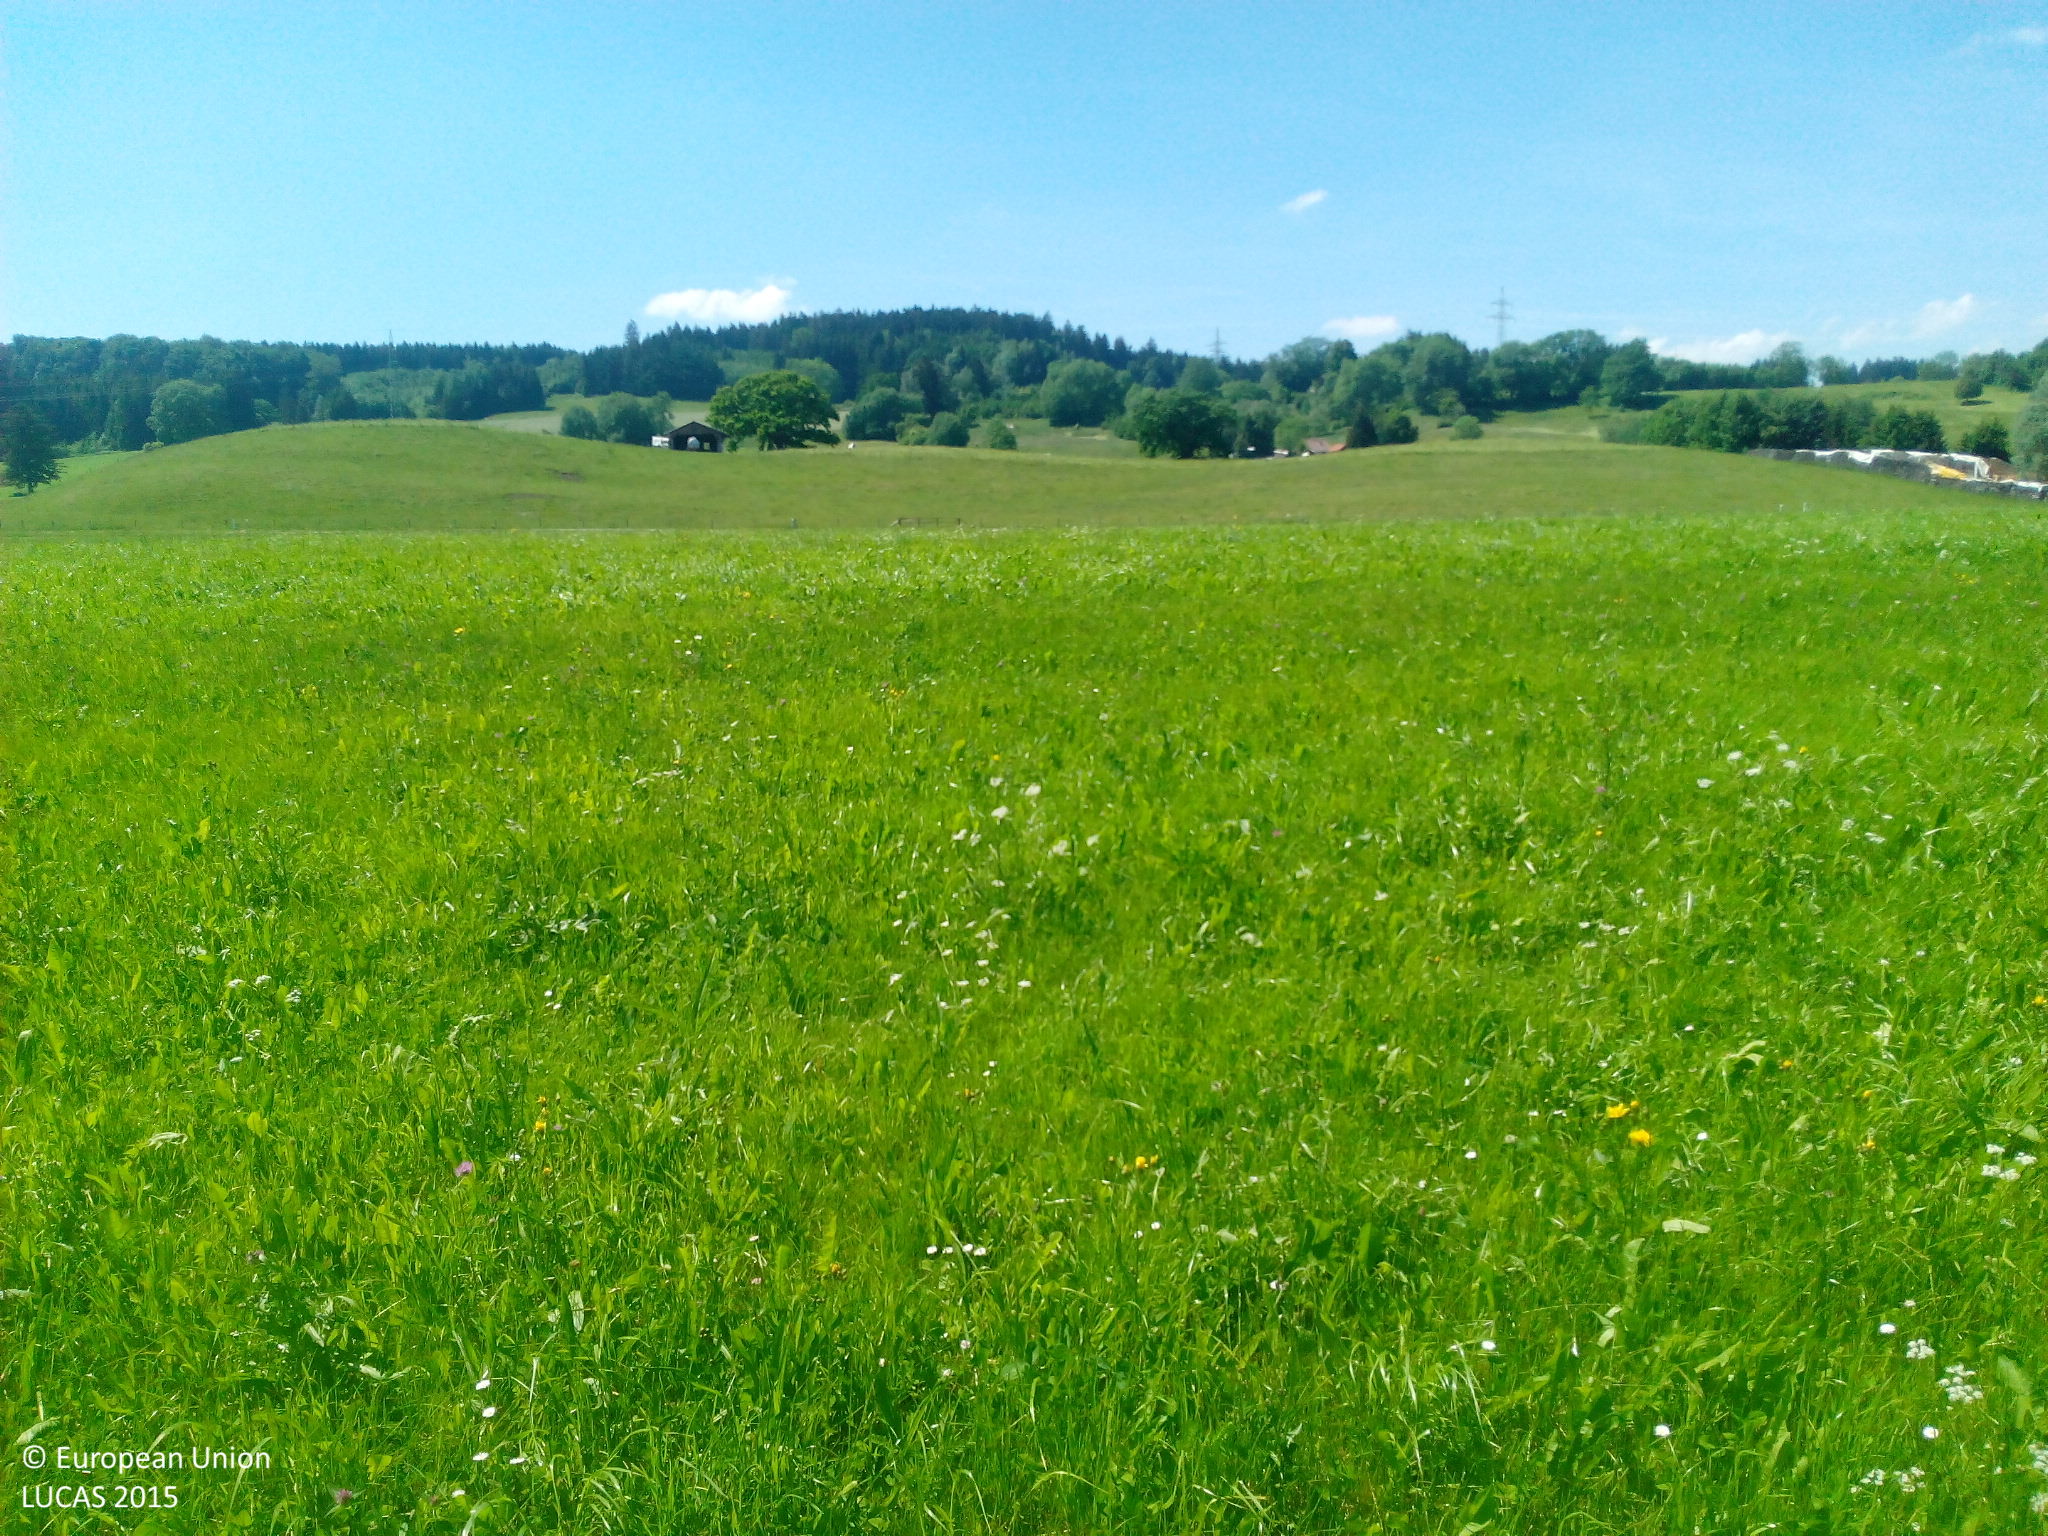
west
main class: Grassland
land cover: Grassland without tree/shrub cover
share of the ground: > 75 %
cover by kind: herbaceous plants 100 %
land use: Agriculture (excluding fallow land and kitchen gardens)
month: June
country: DE
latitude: 47.8620
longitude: 10.6011
